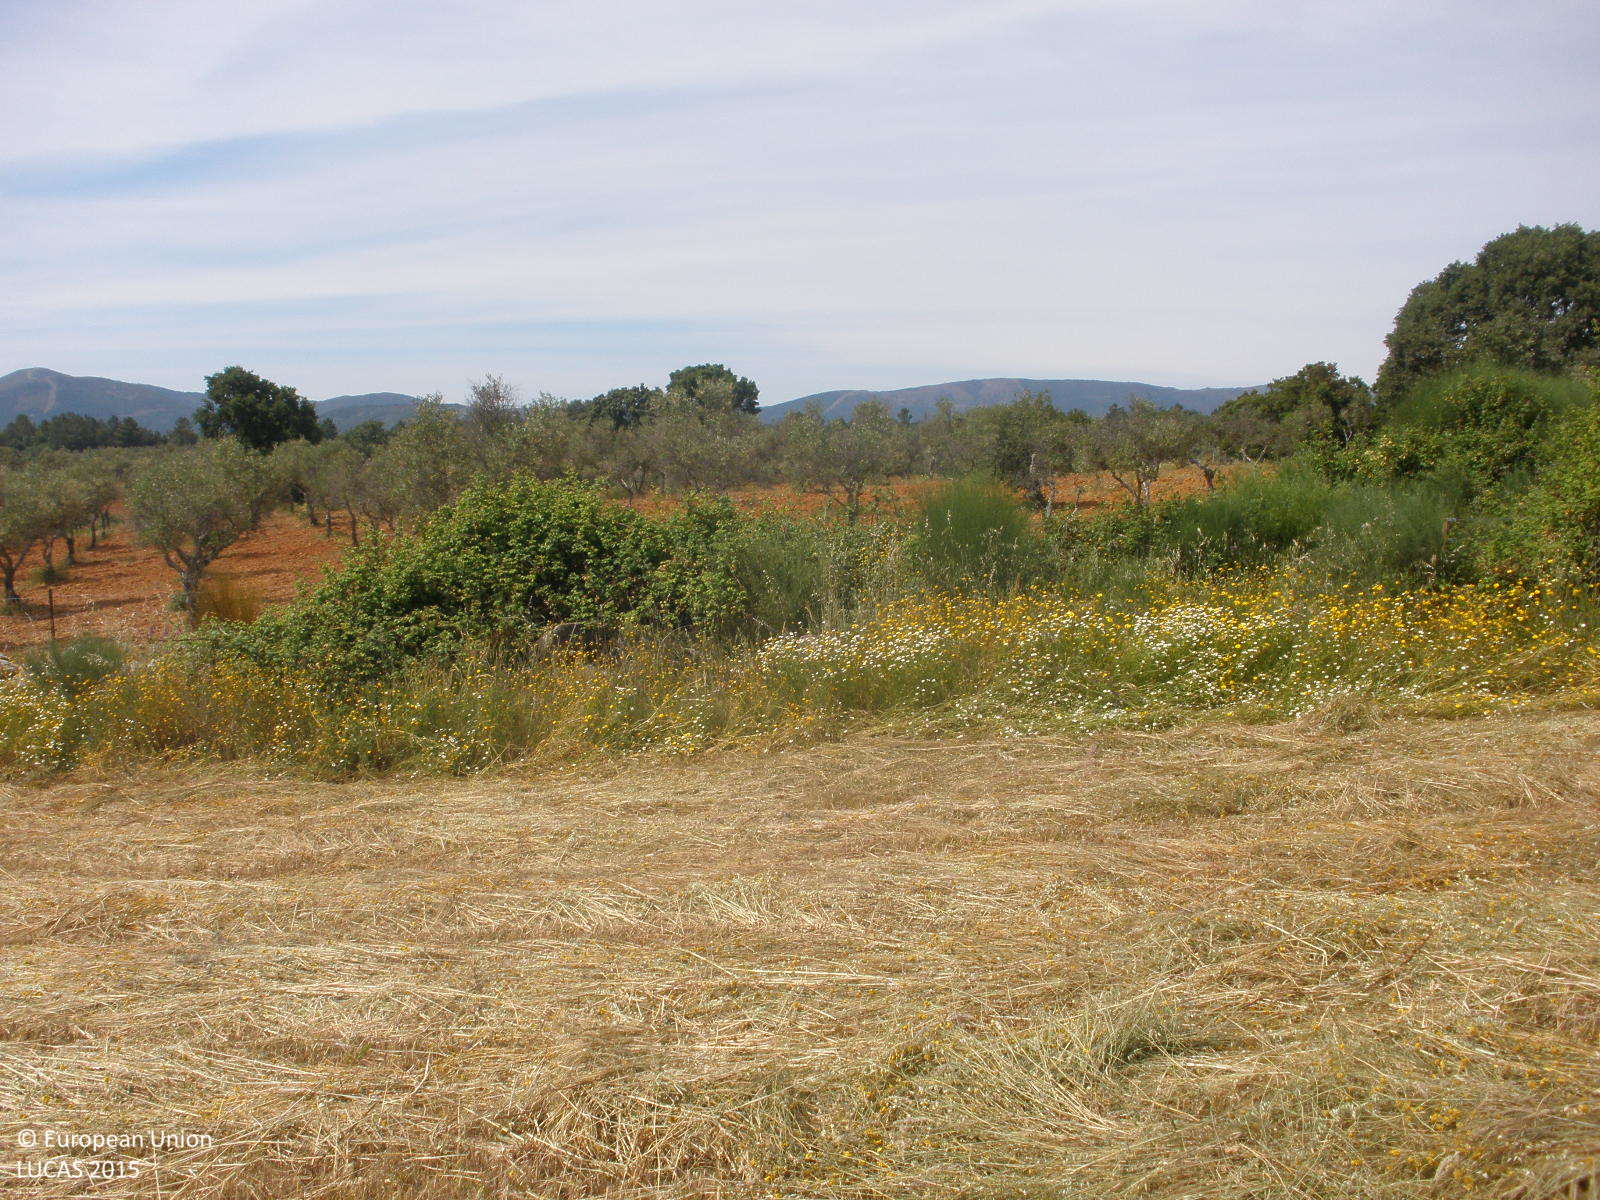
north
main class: Cropland
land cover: Oats
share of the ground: > 75 %
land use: Agriculture (excluding fallow land and kitchen gardens)
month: May
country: ES
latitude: 40.1636
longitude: -6.6284
